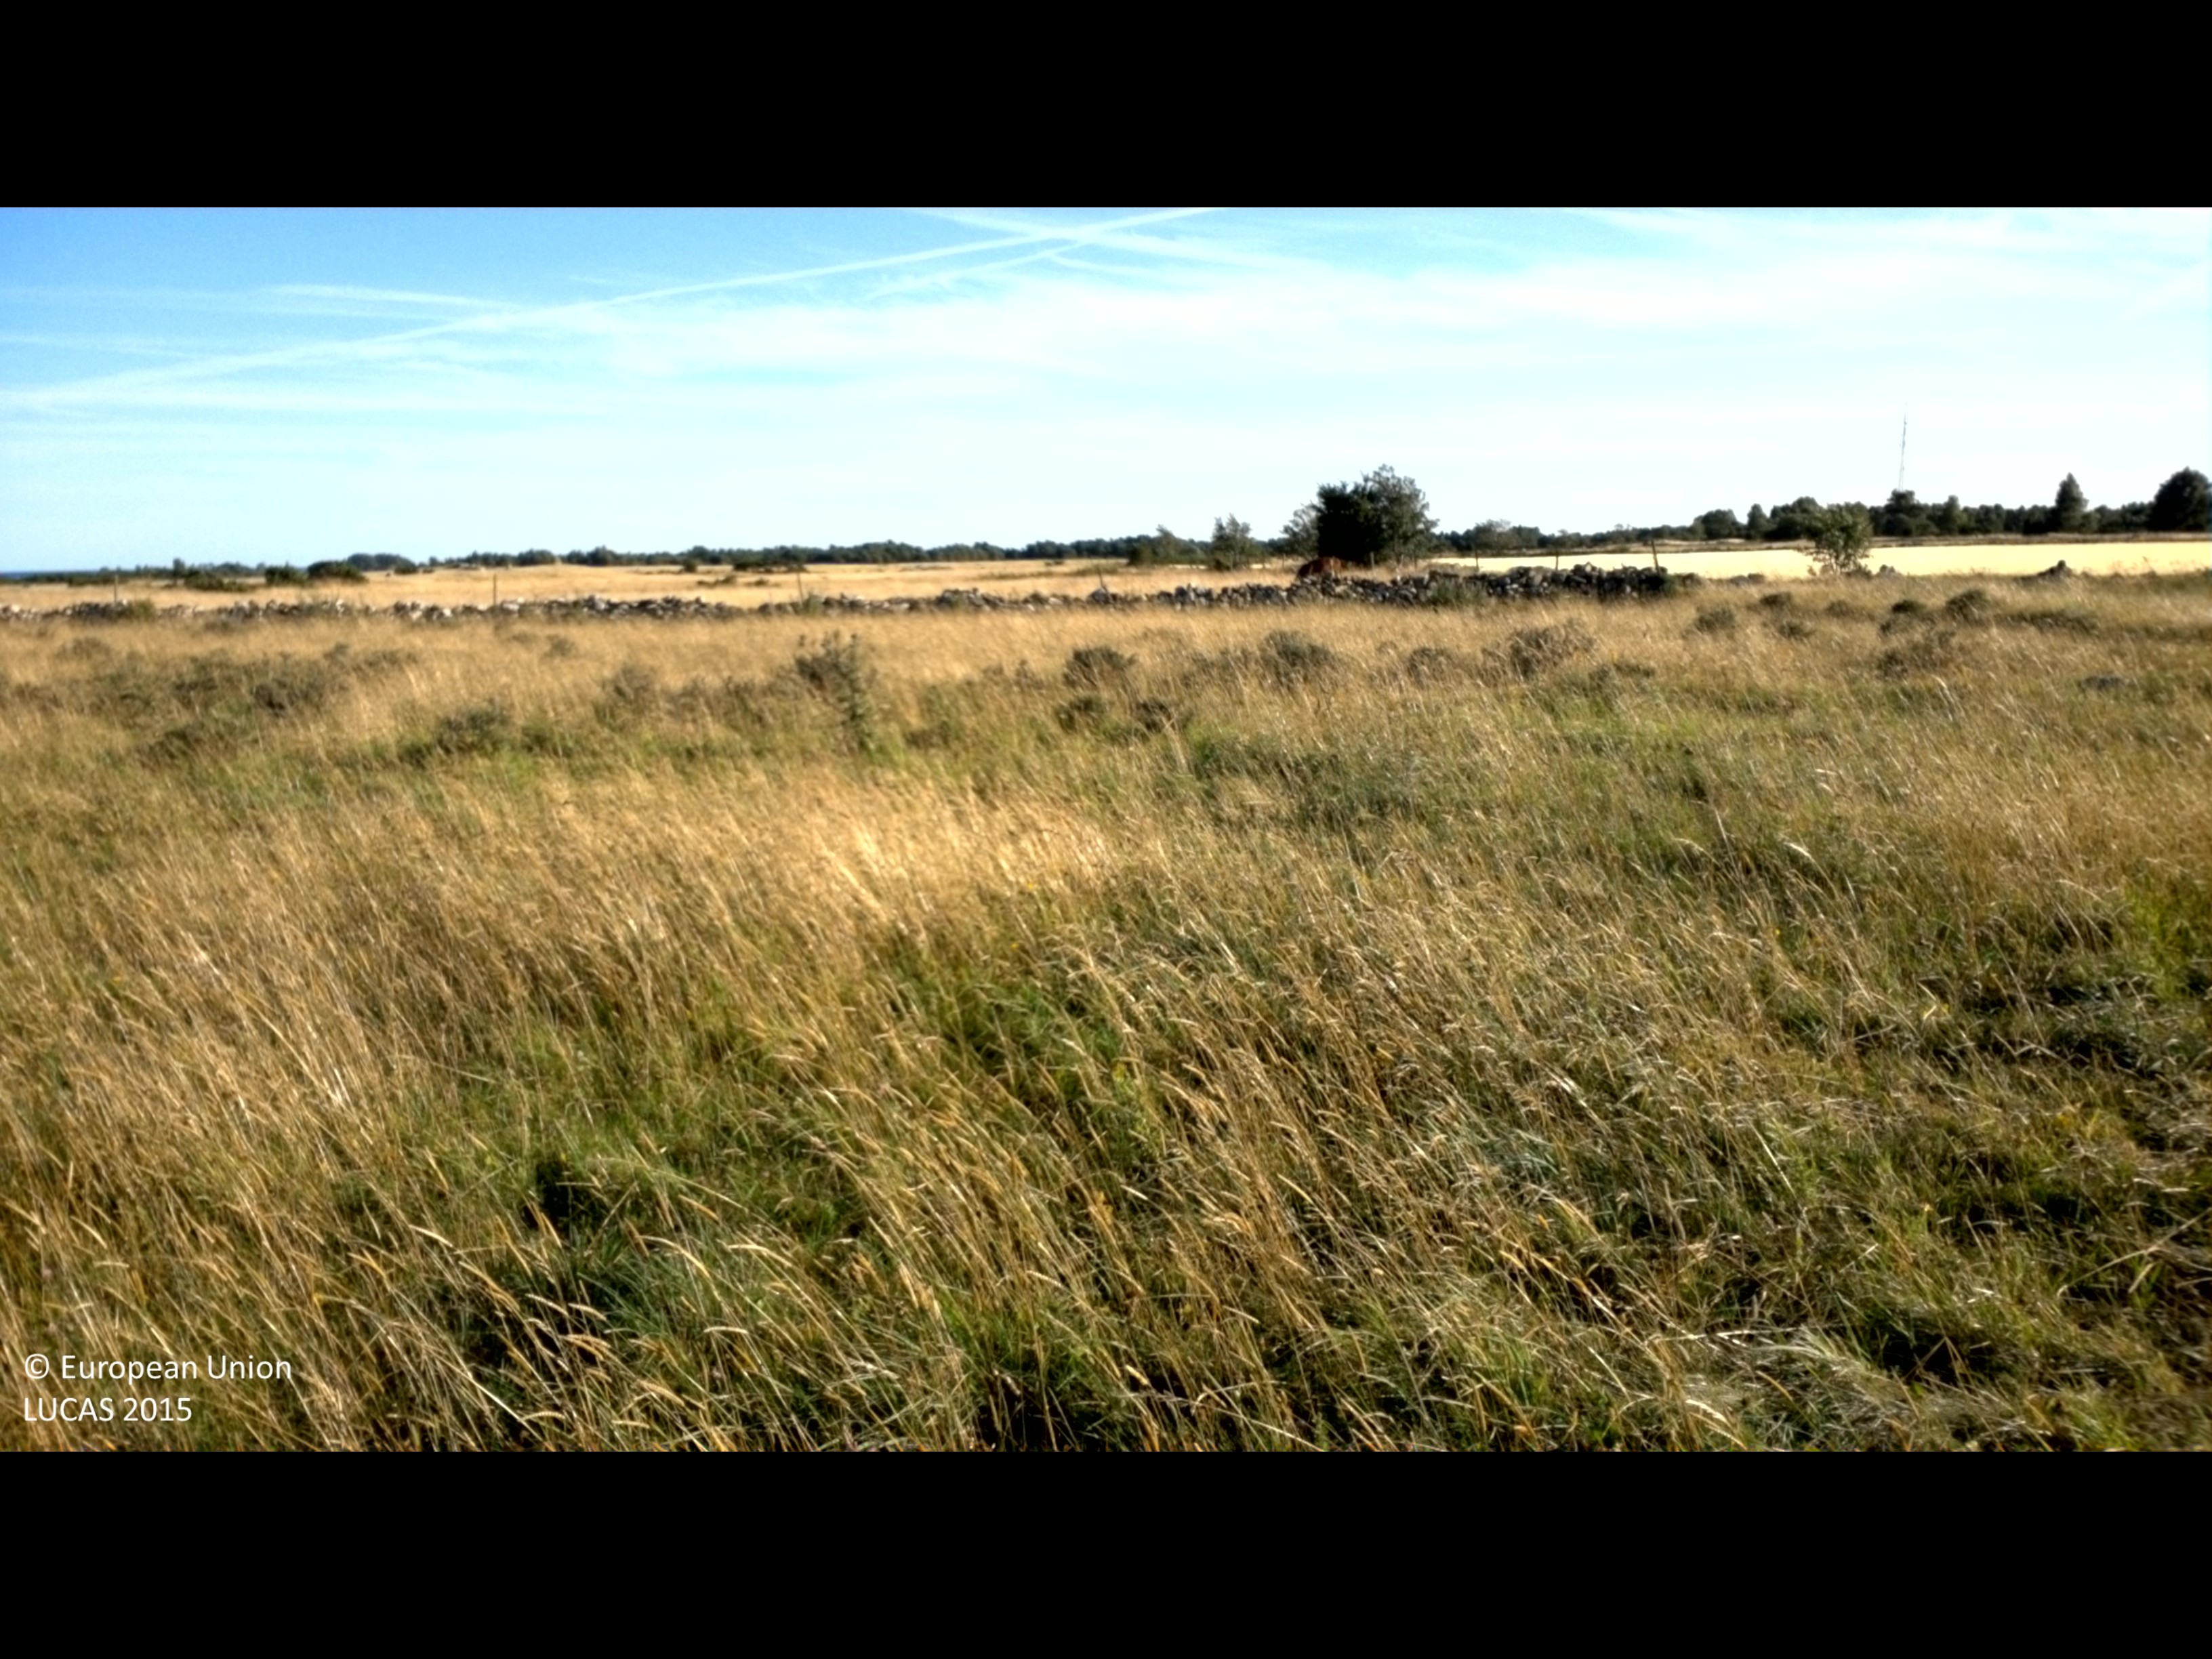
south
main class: Grassland
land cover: Grassland without tree/shrub cover
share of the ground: > 75 %
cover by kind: herbaceous plants 100 %
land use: Agriculture (excluding fallow land and kitchen gardens)
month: July
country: SE
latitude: 56.5580
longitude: 16.6240
